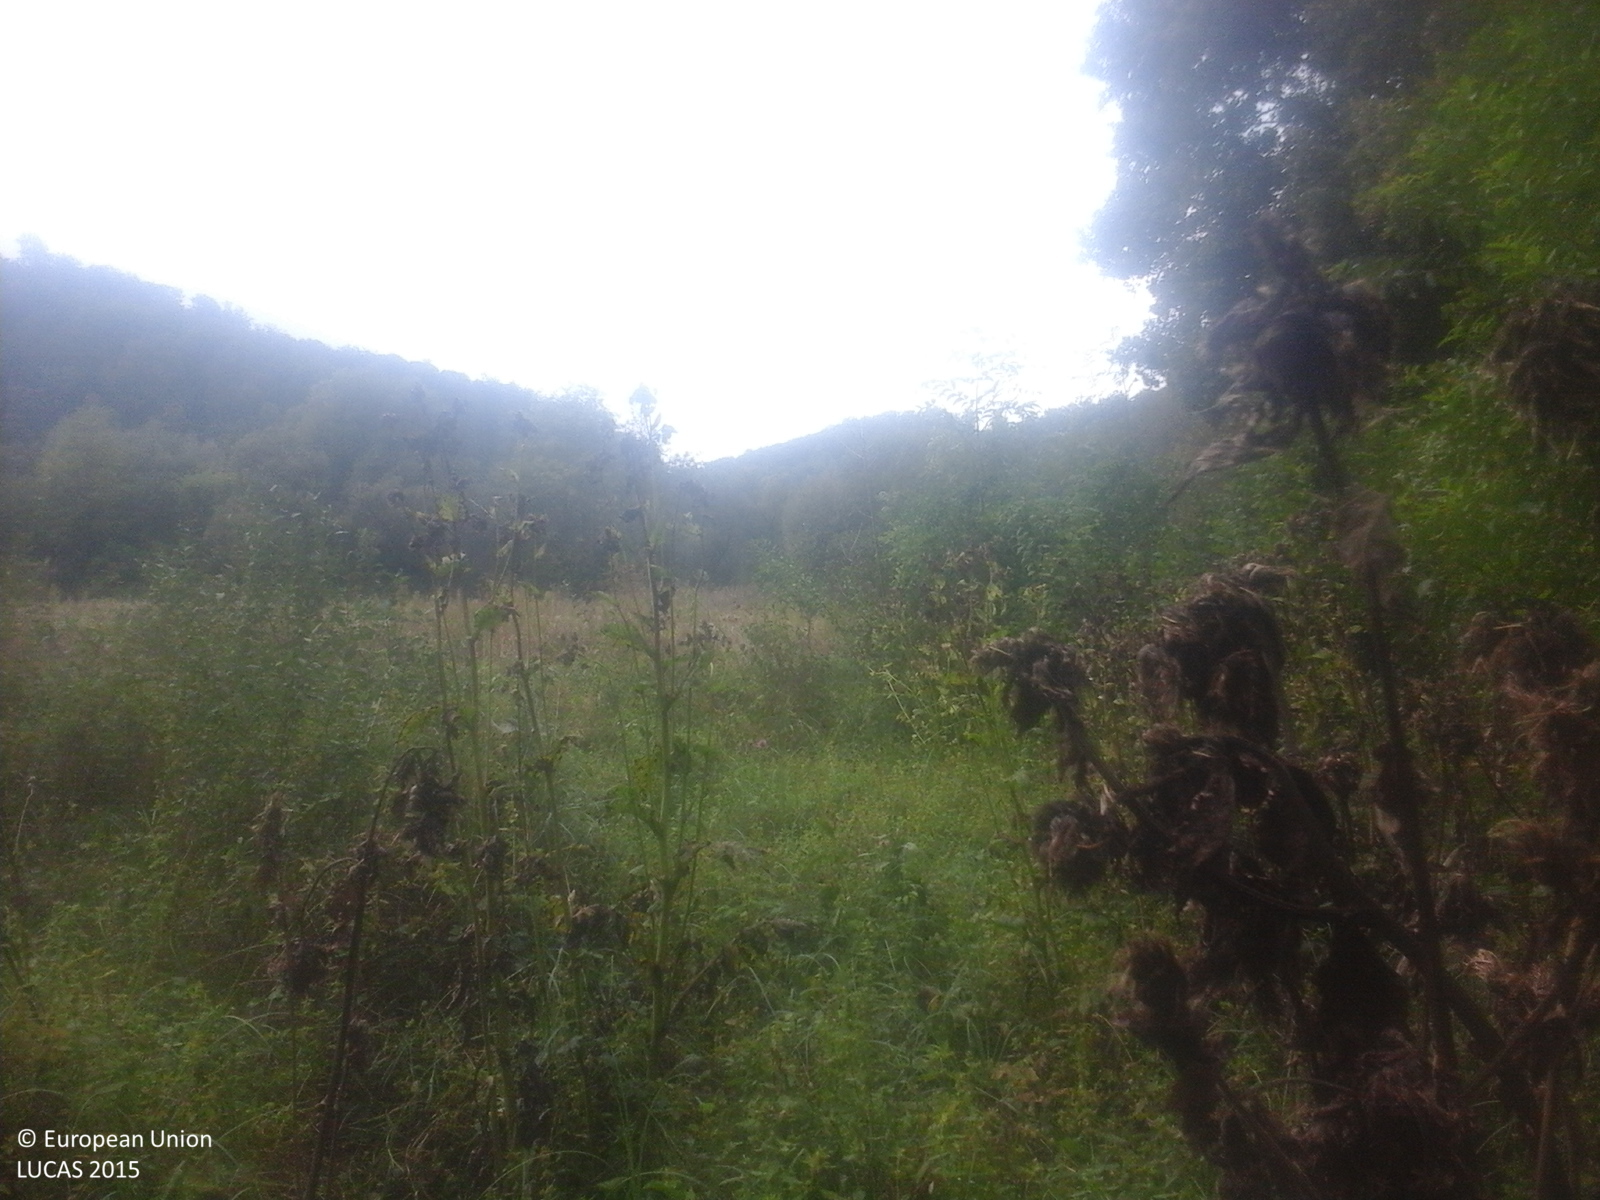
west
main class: Woodland
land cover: Broadleaved woodland
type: mesophytic deciduous forest
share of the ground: > 75 %
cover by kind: broadleaved forest trees 100 %
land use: Forestry
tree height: > 5 m
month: September
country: RO
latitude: 46.8388
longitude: 22.3101
